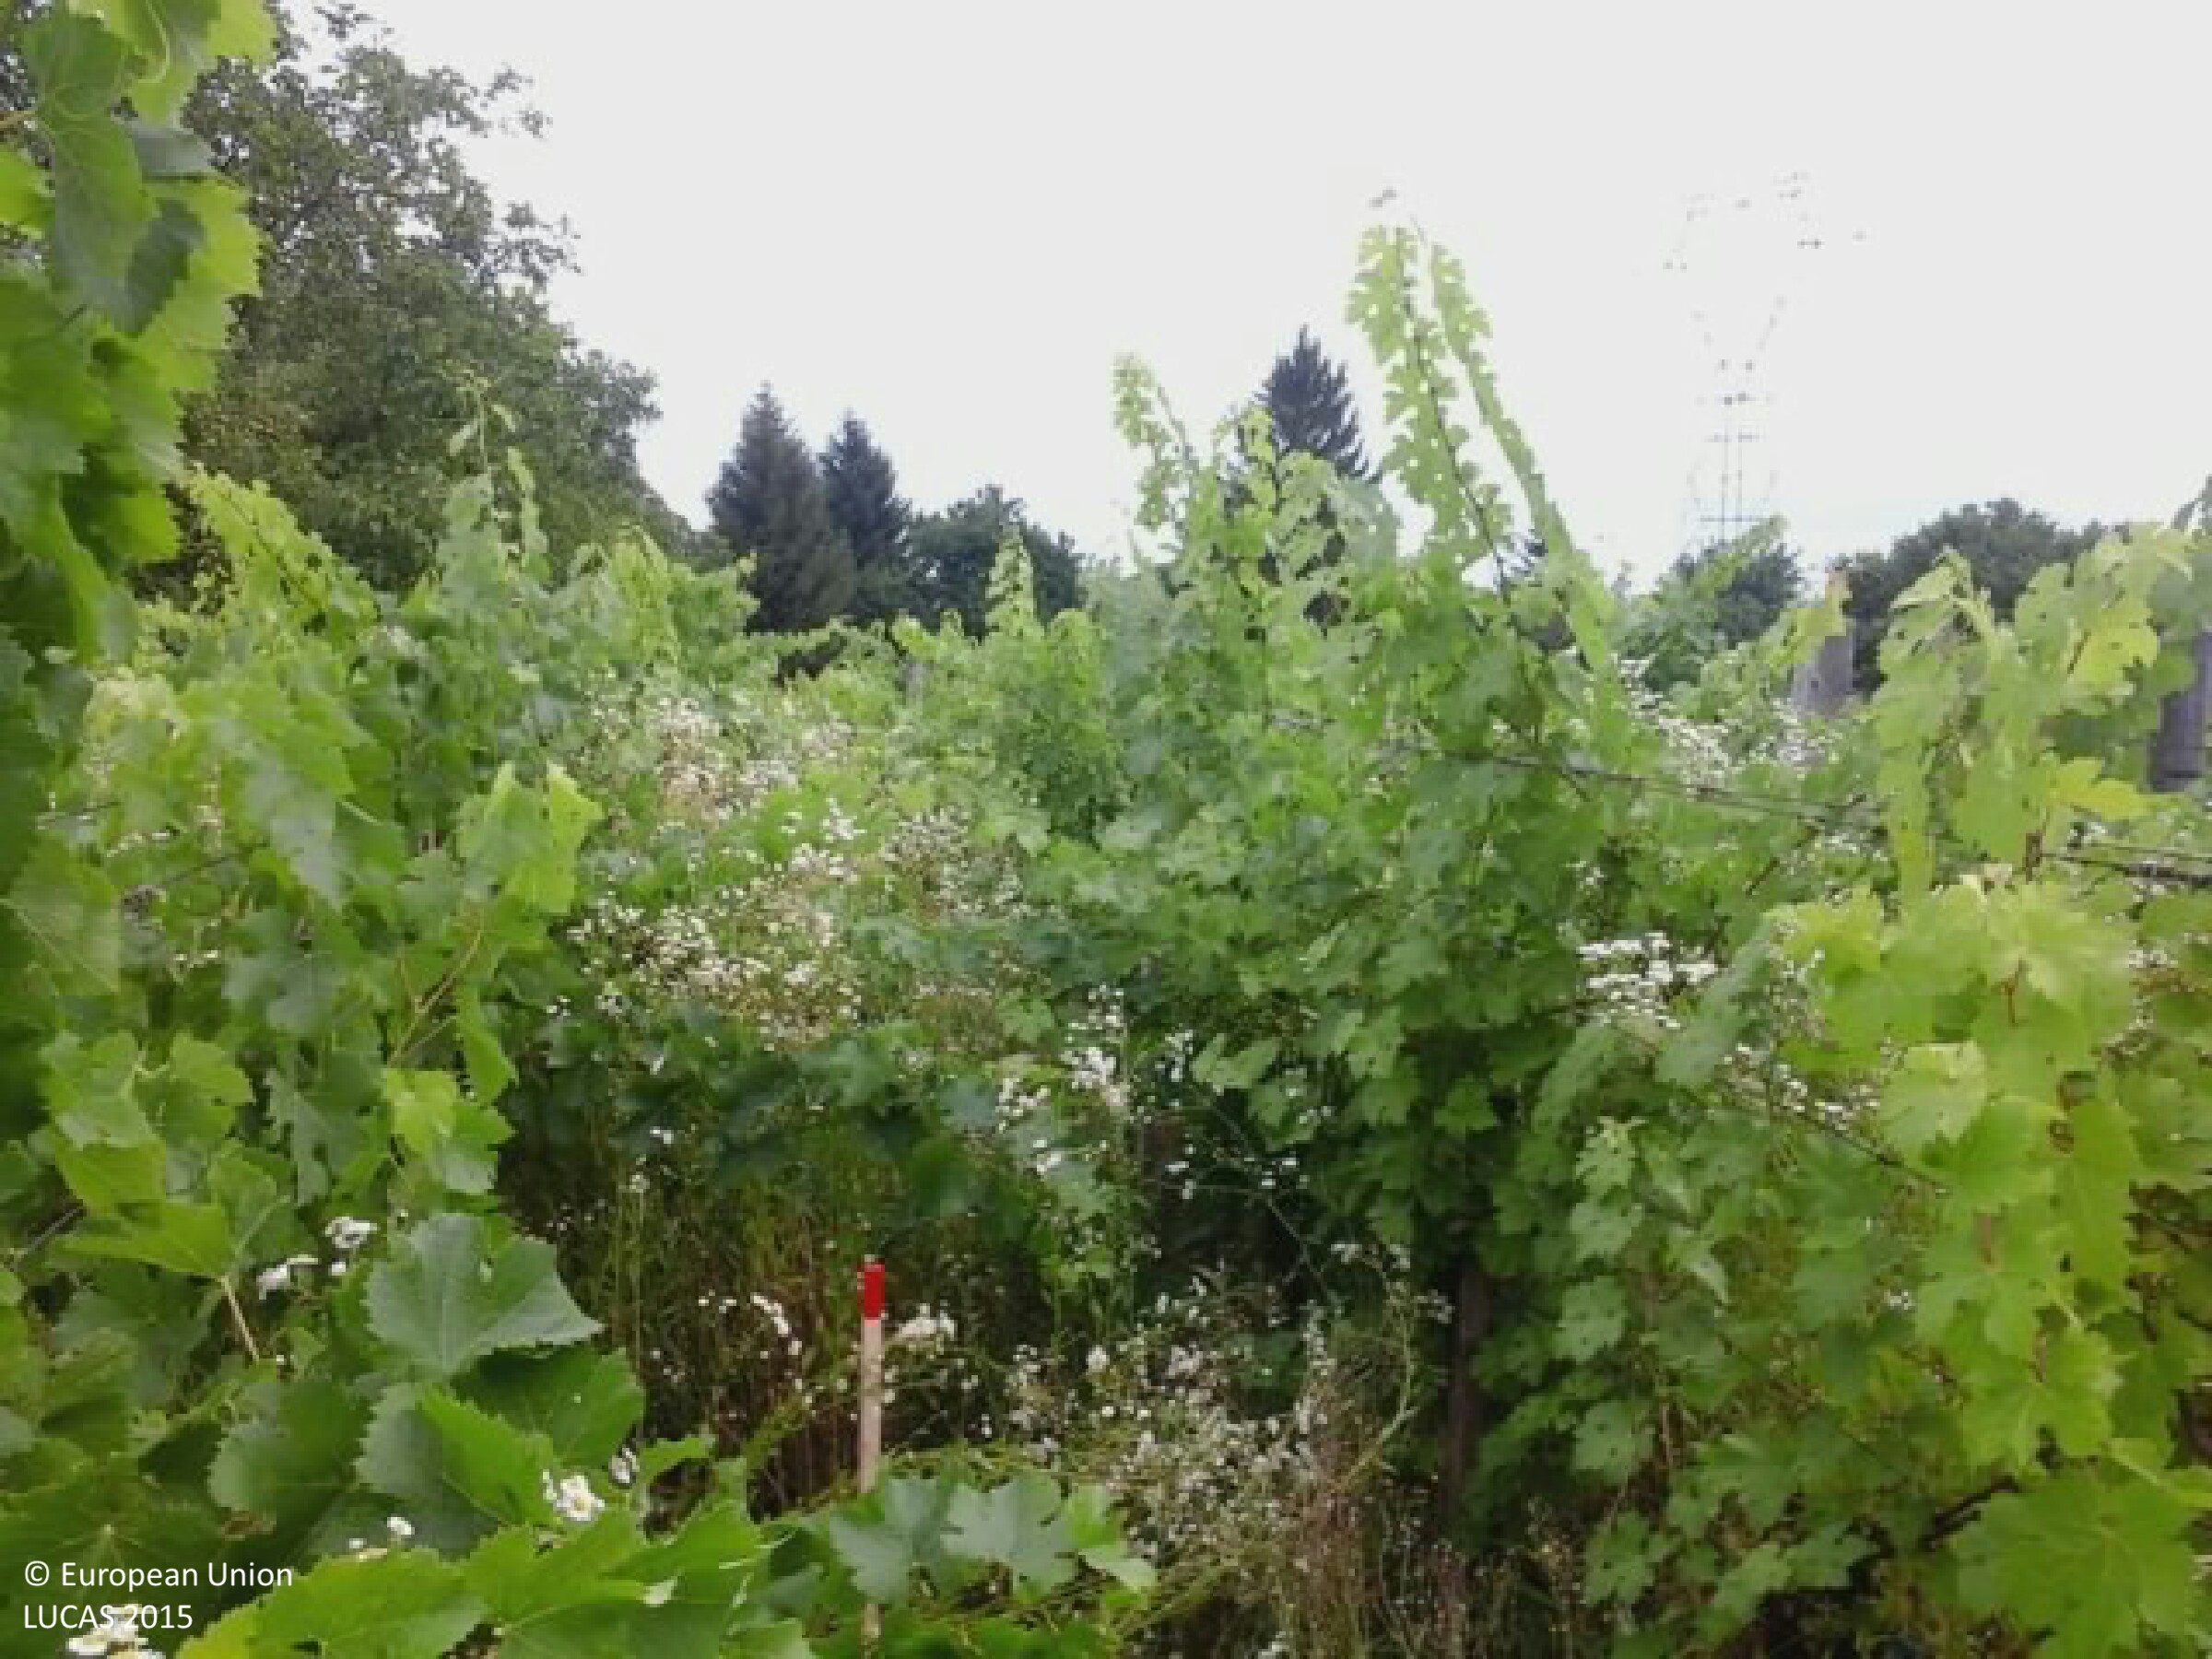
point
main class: Cropland
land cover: Vineyards
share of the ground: 25 - 50 %
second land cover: Spontaneously vegetated surfaces
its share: 50 - 75 %
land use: Abandoned areas
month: July
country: HU
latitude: 46.5124
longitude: 17.1064
